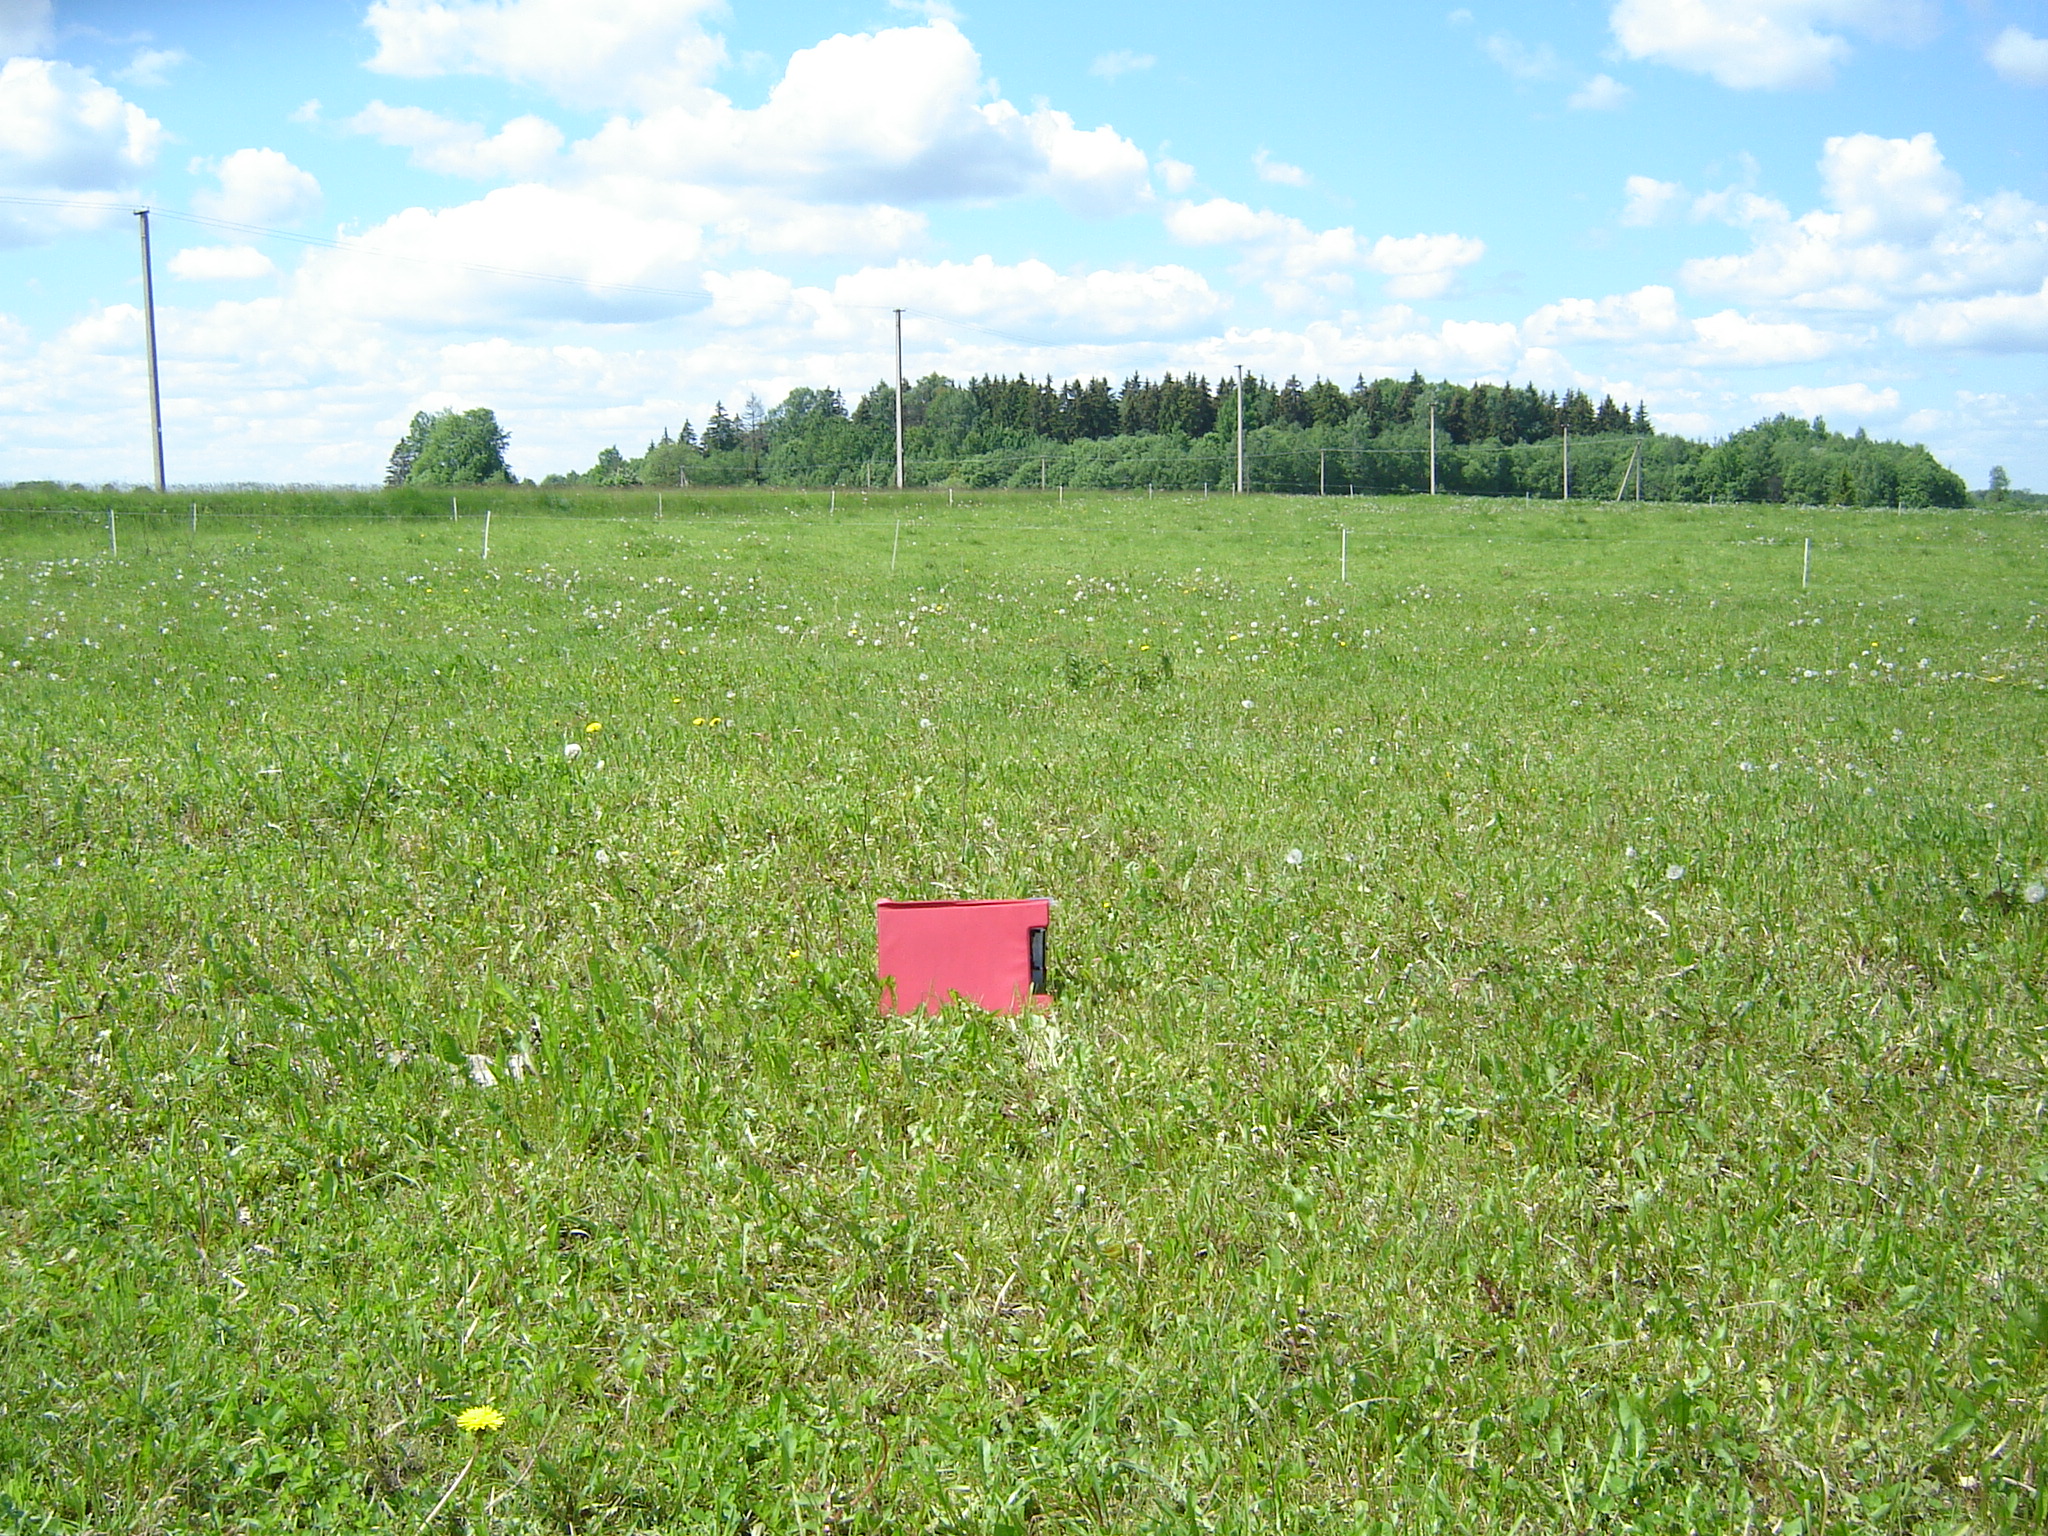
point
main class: Grassland
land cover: Grassland without tree/shrub cover
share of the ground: > 75 %
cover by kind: herbaceous plants 100 %
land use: Agriculture (excluding fallow land and kitchen gardens)
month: May
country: LT
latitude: 55.8070
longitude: 25.1931
